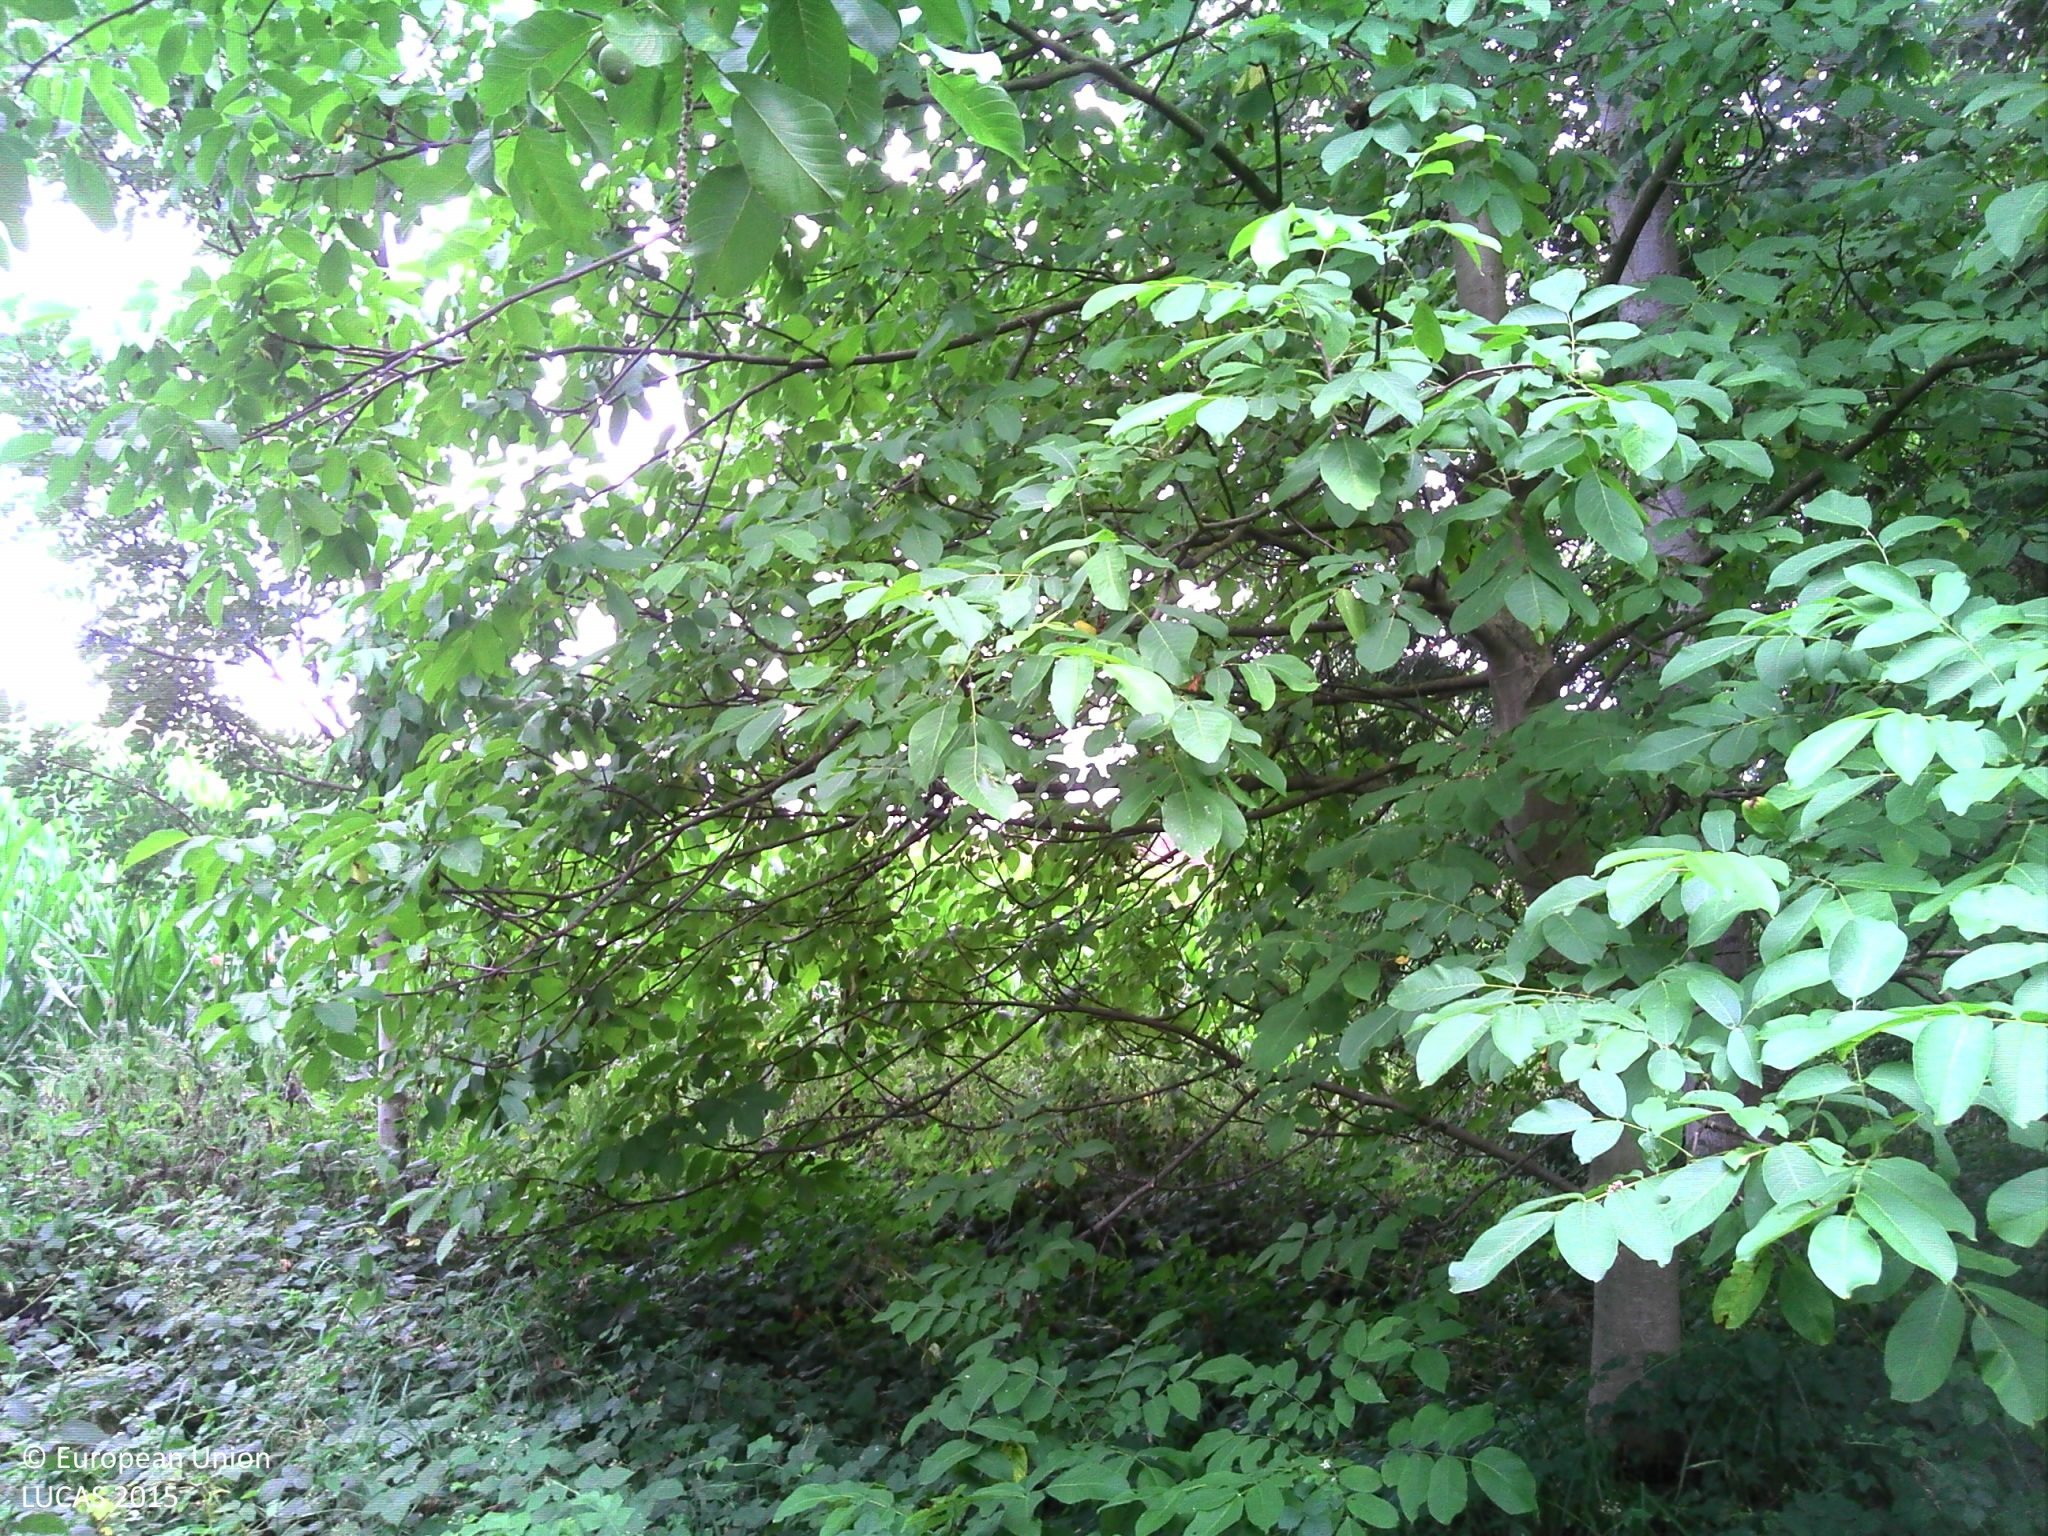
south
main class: Grassland
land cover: Spontaneously vegetated surfaces
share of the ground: > 75 %
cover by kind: herbaceous plants 100 %
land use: Semi-natural and natural areas not in use
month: July
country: FR
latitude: 48.6300
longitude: 7.6263
